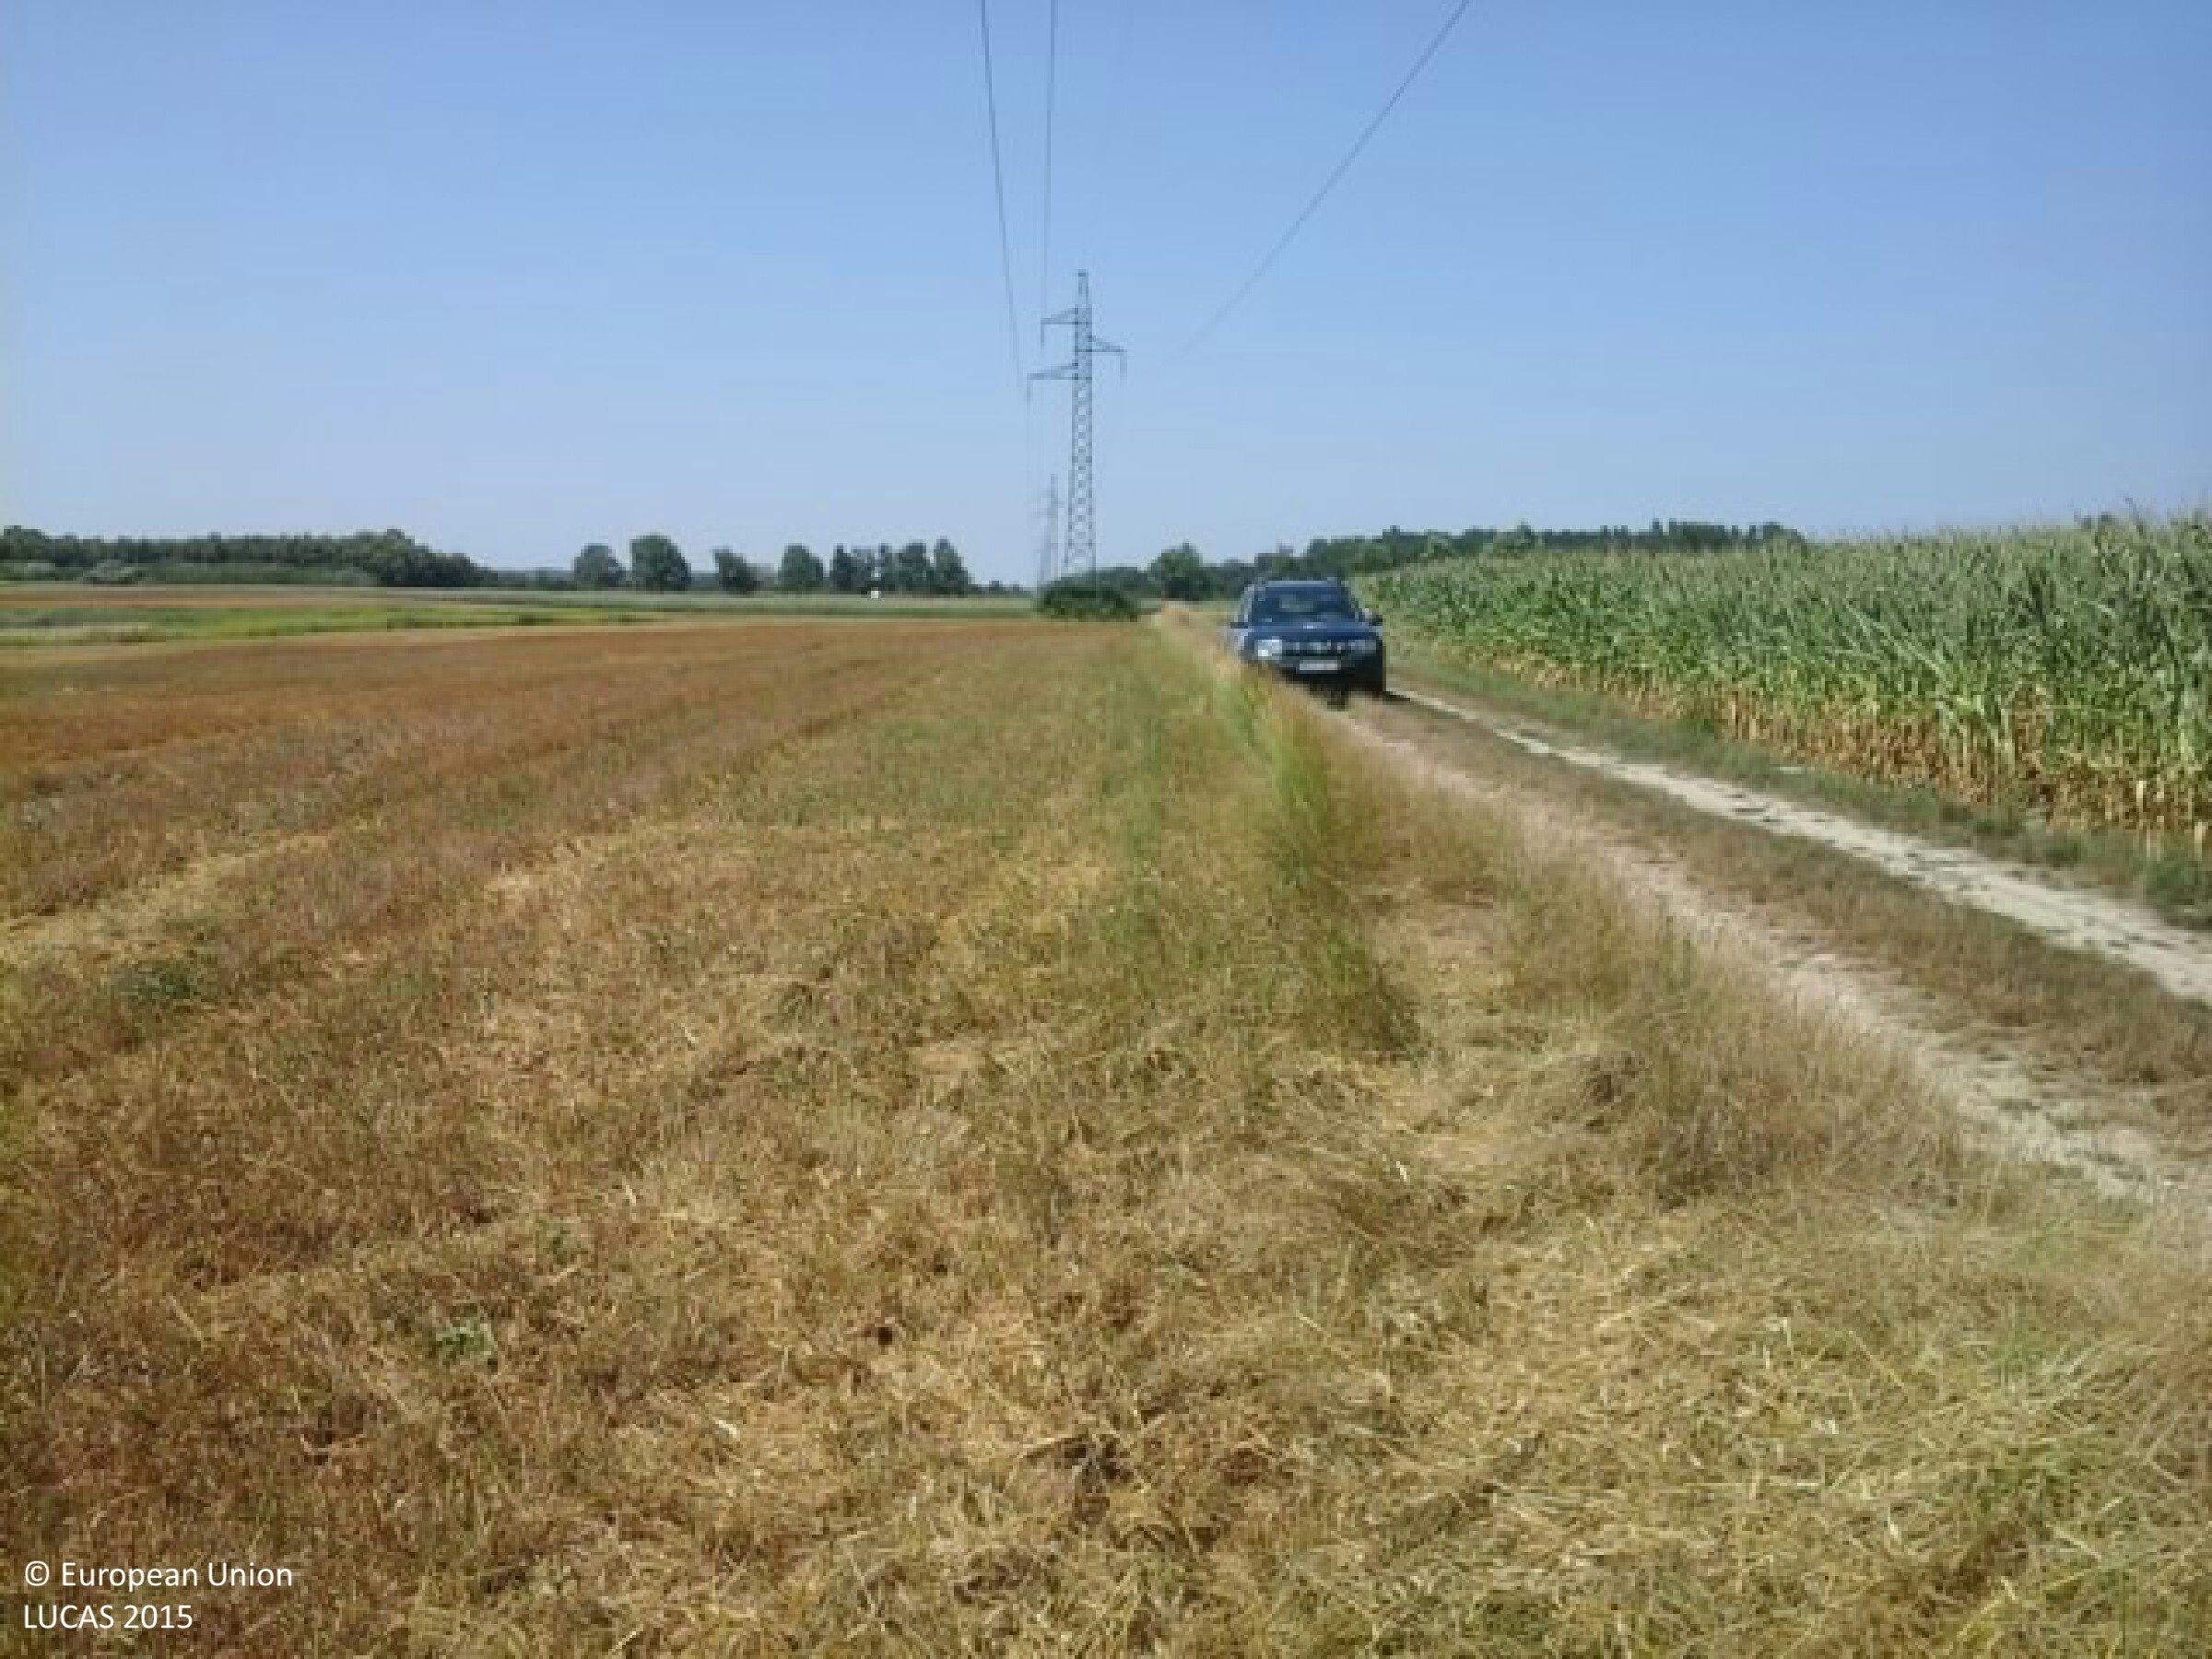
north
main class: Cropland
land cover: Common wheat
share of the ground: < 10 %
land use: Agriculture (excluding fallow land and kitchen gardens)
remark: Harvested field
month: July
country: HU
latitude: 46.2581
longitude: 17.1247
